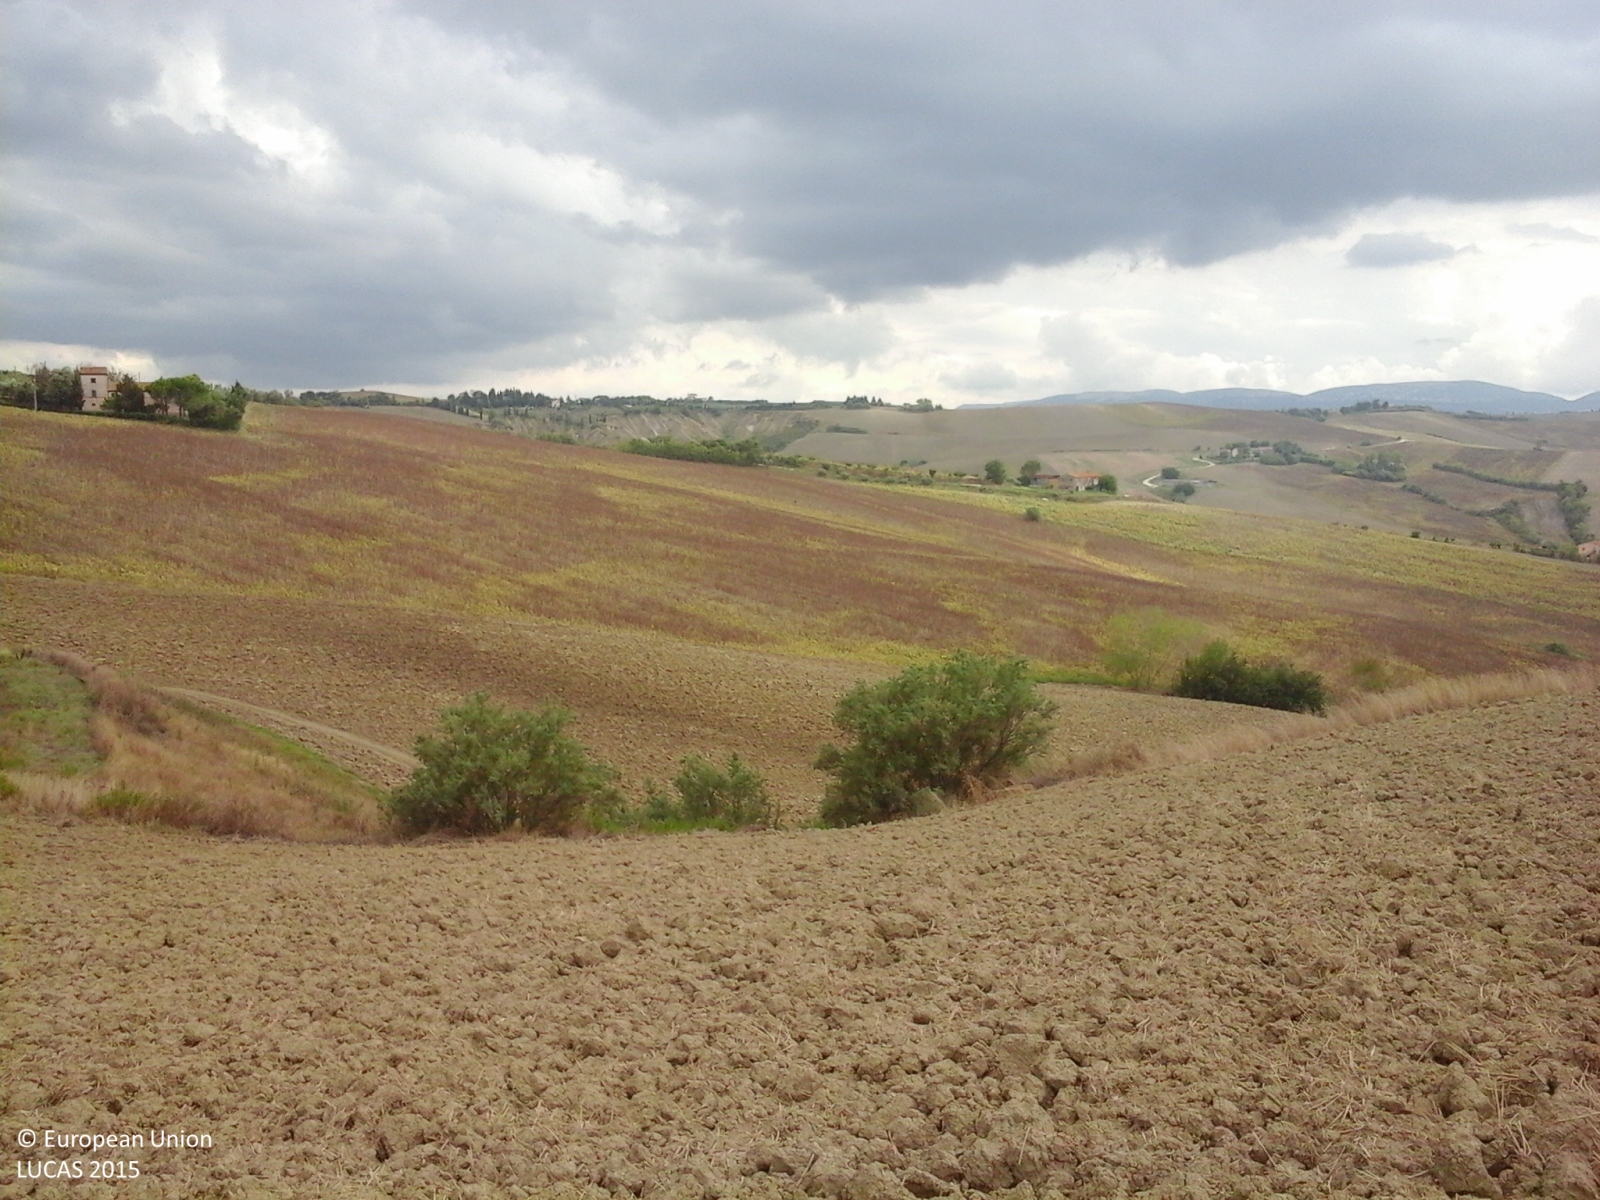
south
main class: Cropland
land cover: Durum wheat
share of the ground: < 10 %
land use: Agriculture (excluding fallow land and kitchen gardens)
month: August
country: IT
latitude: 43.4866
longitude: 13.2685
